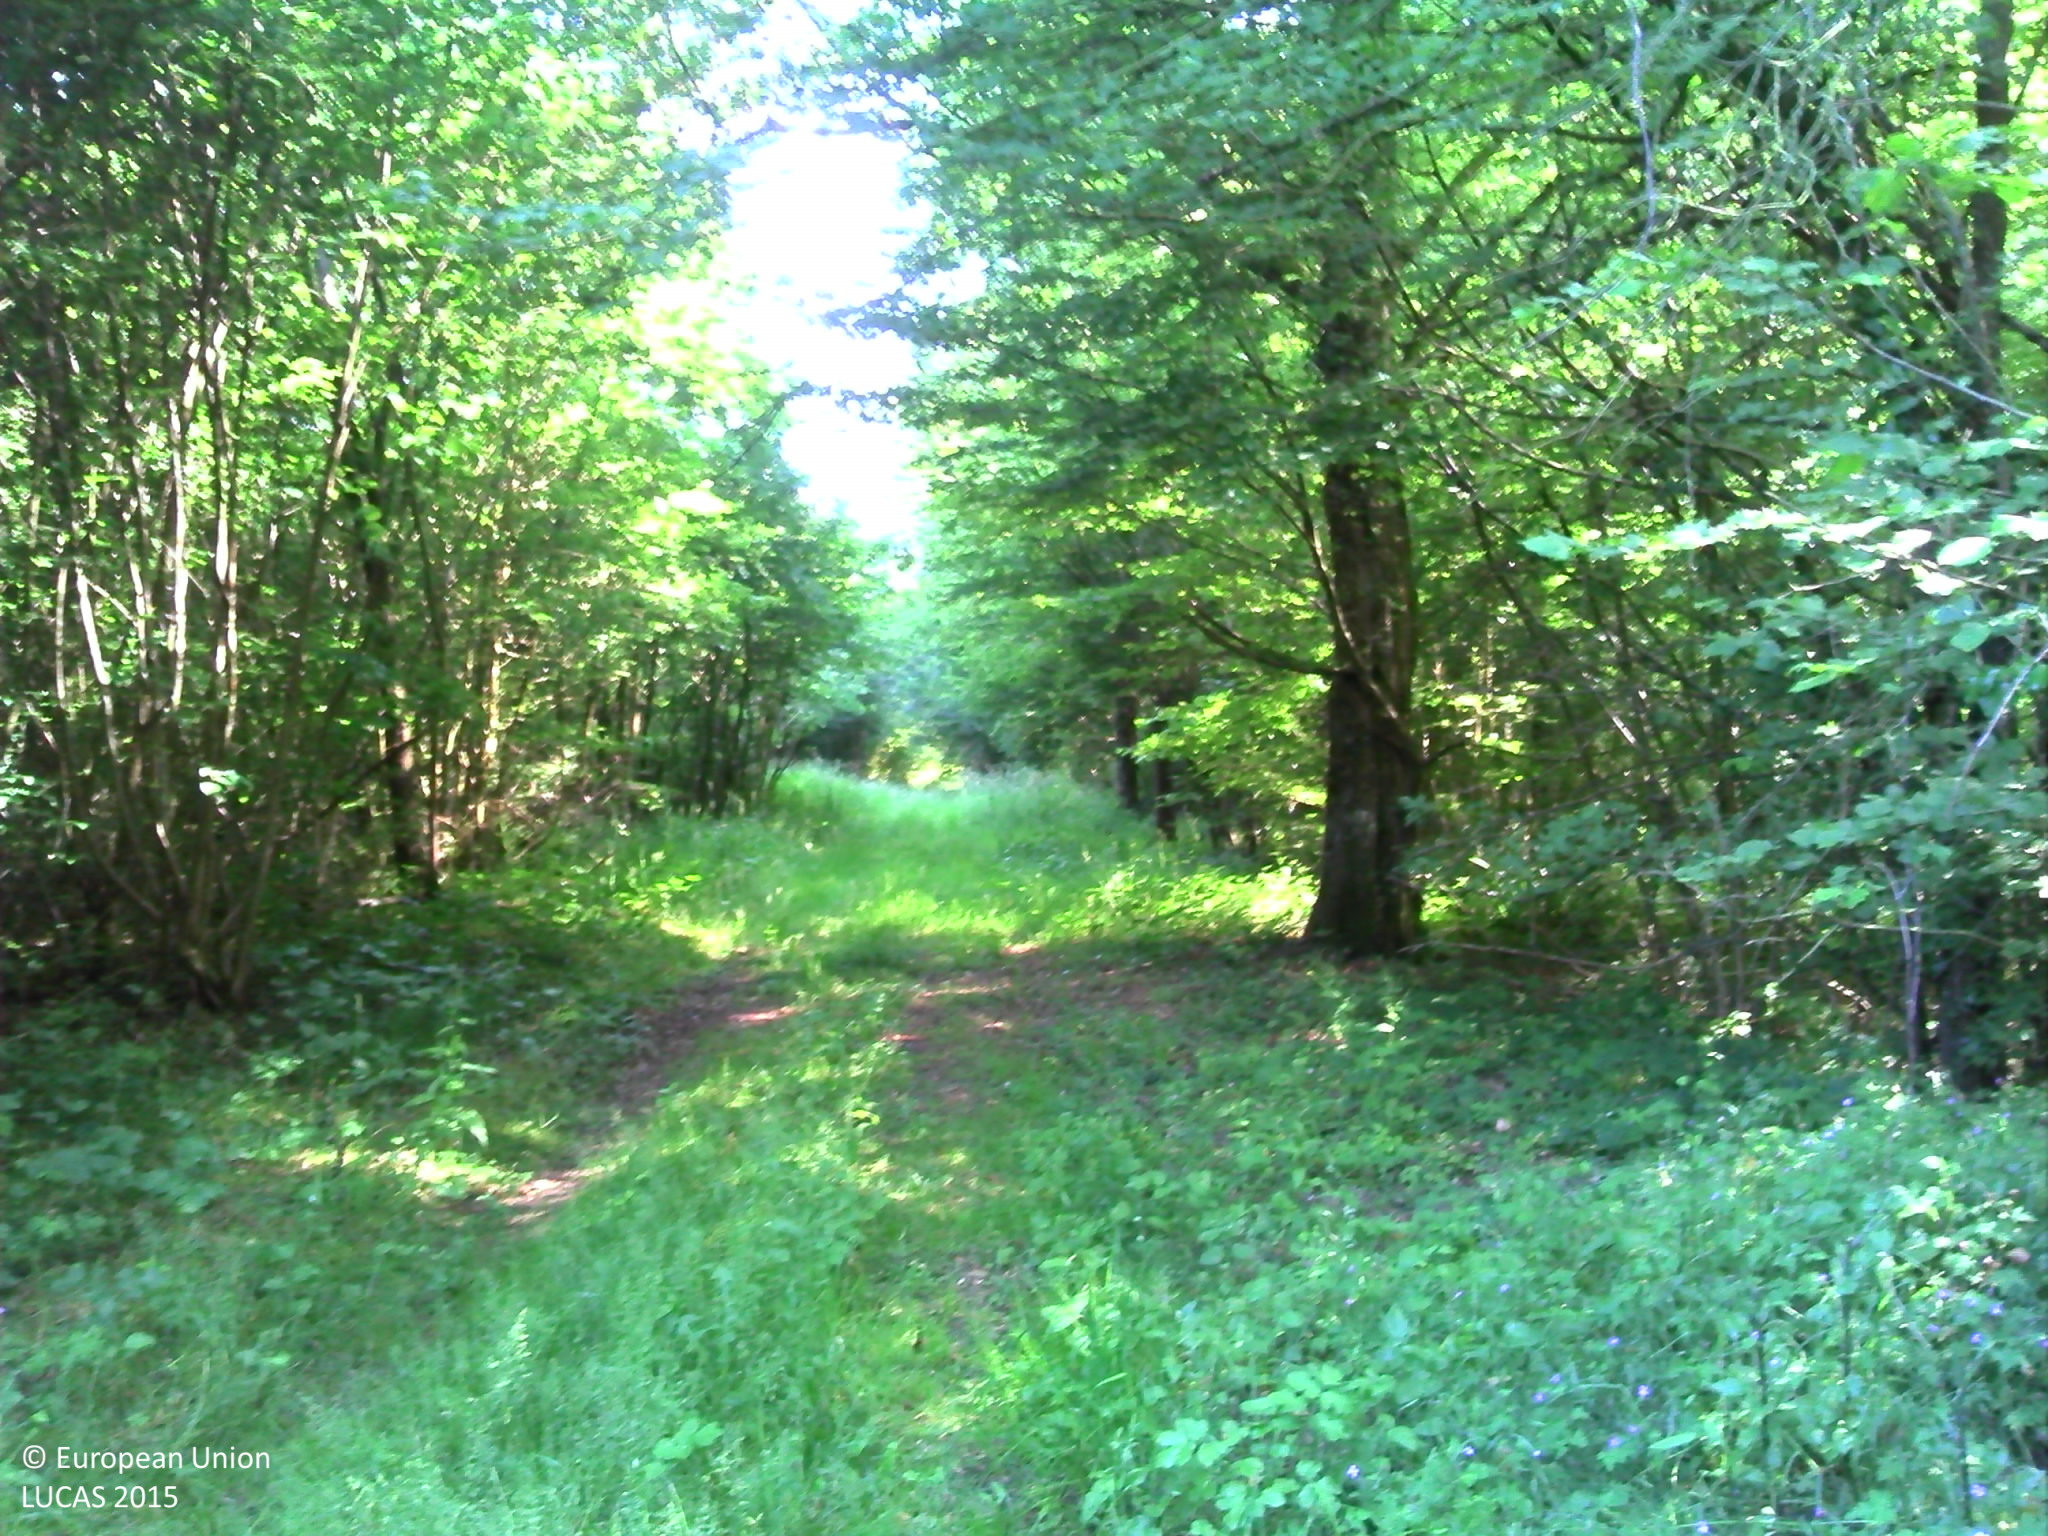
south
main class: Woodland
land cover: Broadleaved woodland
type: mesophytic deciduous forest
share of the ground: > 75 %
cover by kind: broadleaved forest trees 85 %, herbaceous plants 15 %
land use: Forestry
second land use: Amenities, museums, leisure
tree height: > 5 m
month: June
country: FR
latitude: 47.1749
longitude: 5.0530
